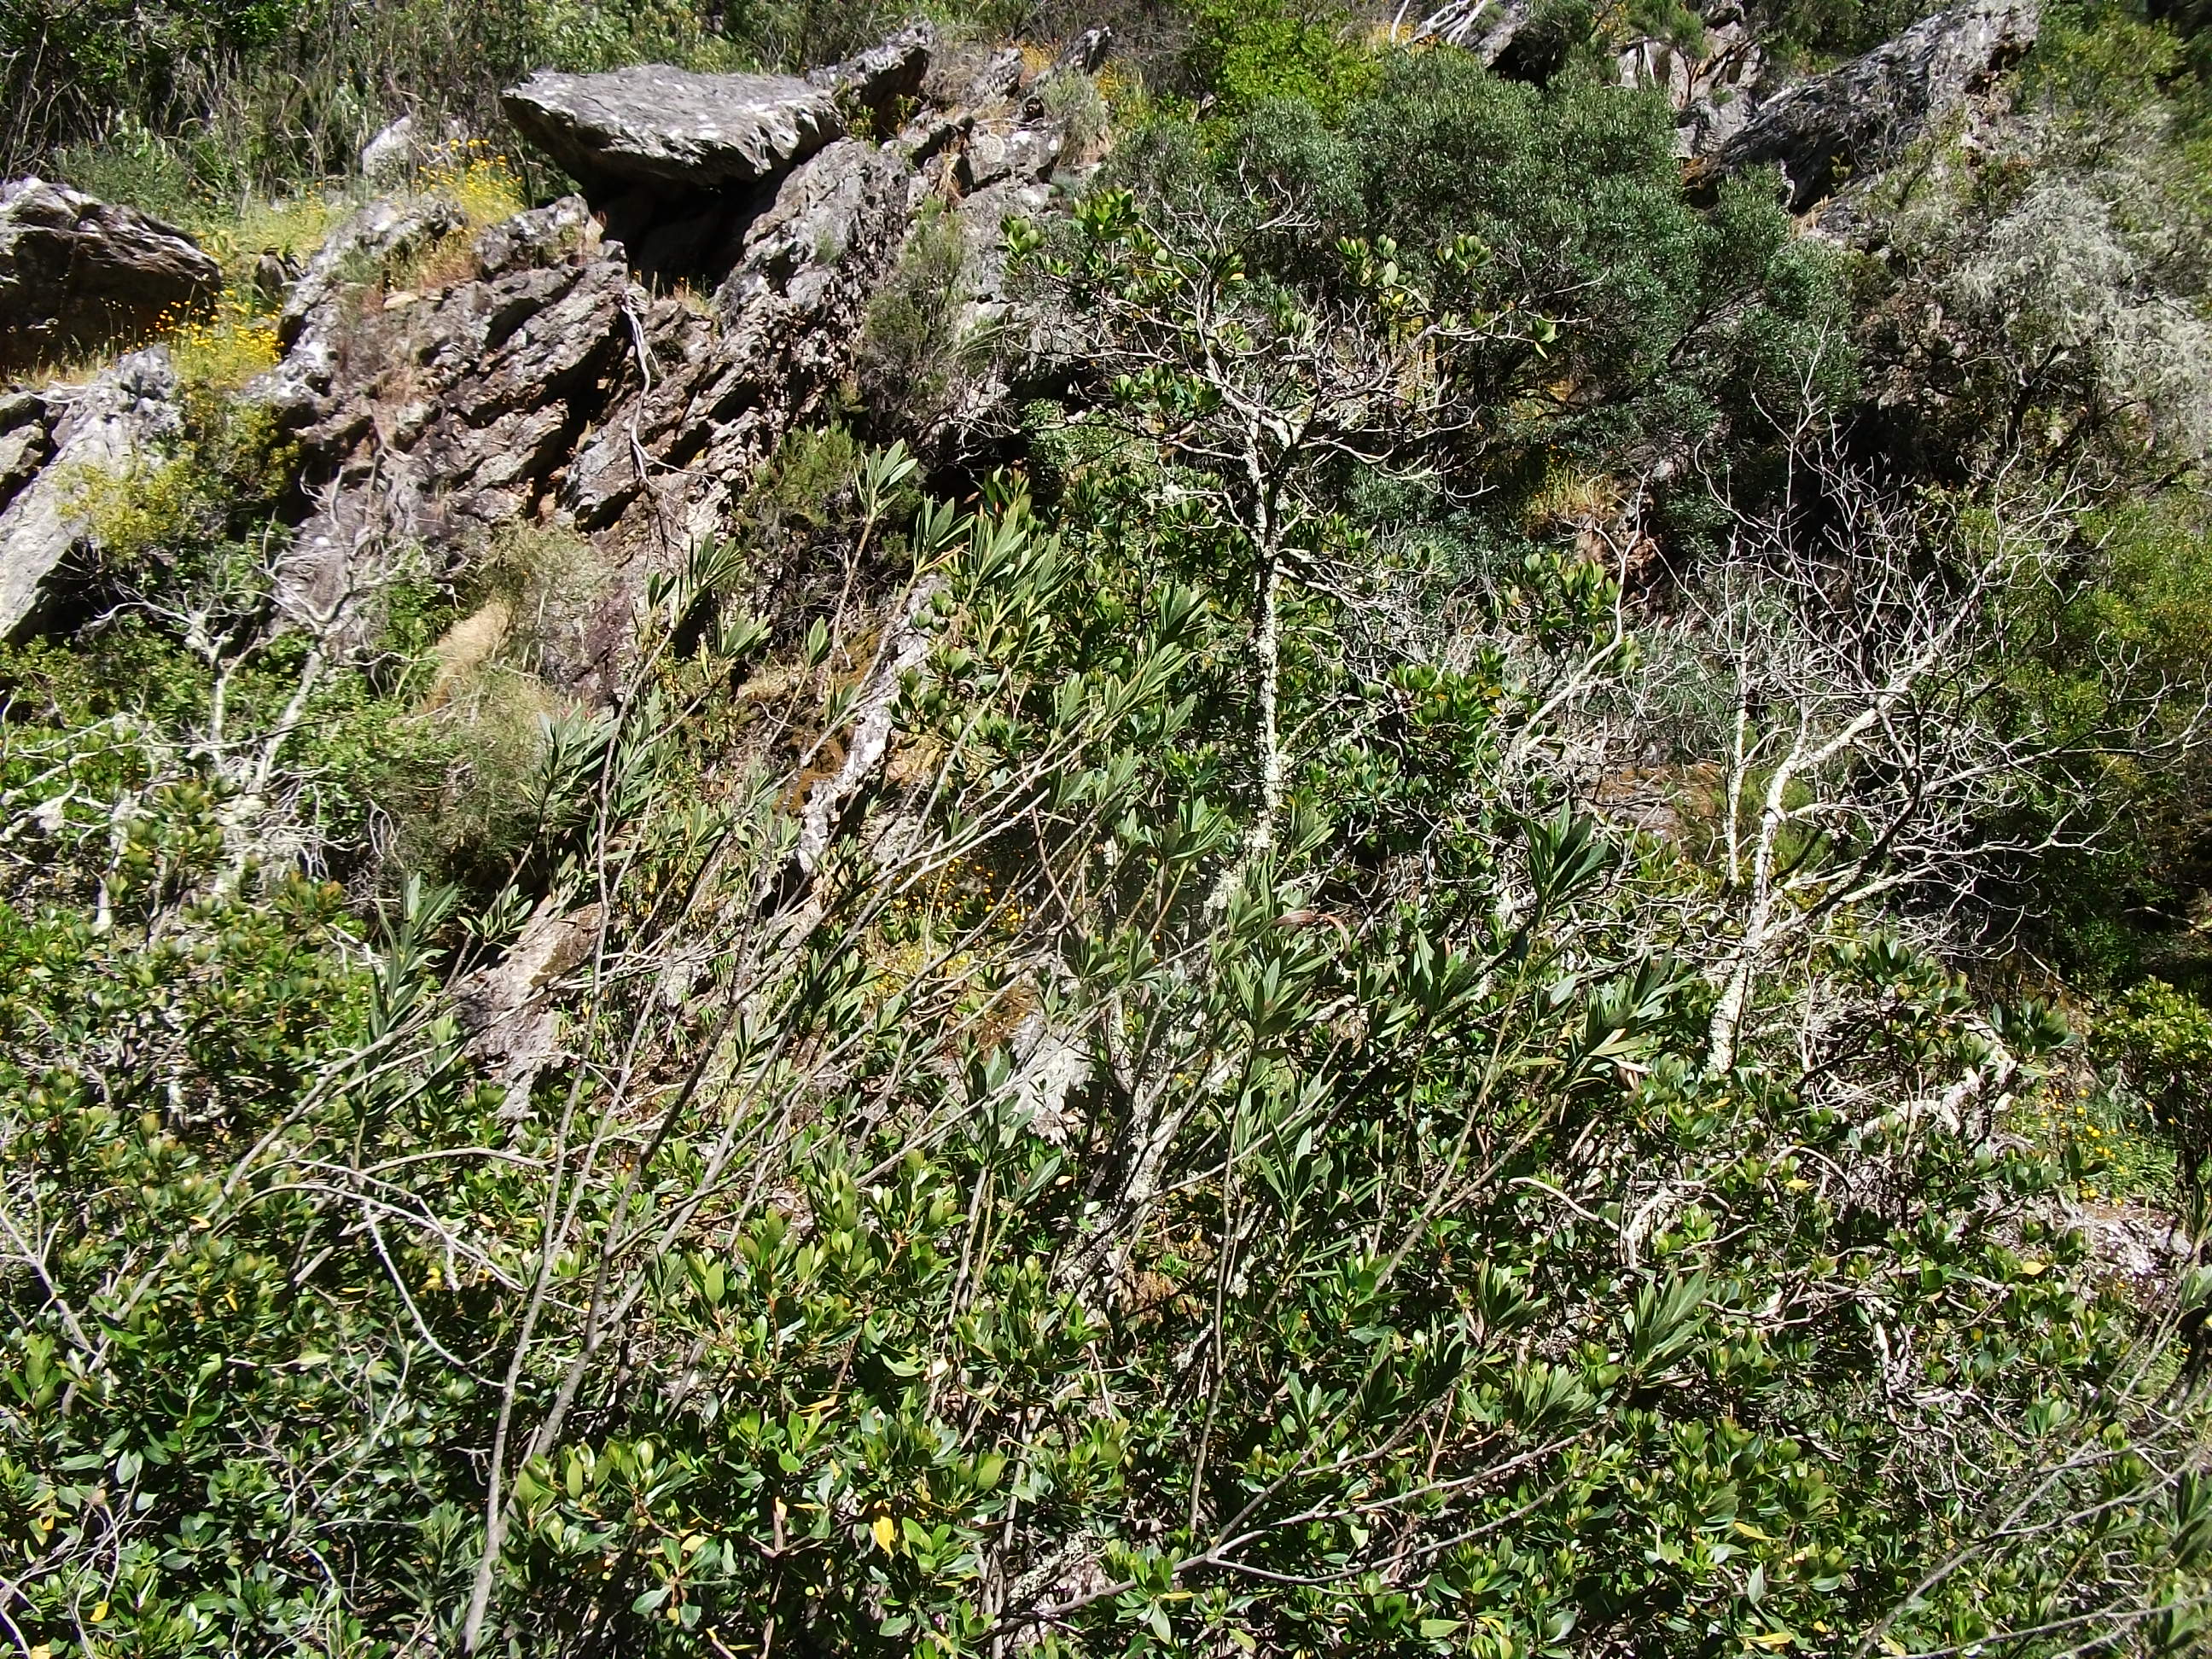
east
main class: Shrubland
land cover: Shrubland with sparse tree cover
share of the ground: 50 - 75 %
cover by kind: shrubs 70 %, herbaceous plants 15 %, consolidated bare surface 10 %, broadleaved forest trees 5 %
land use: Semi-natural and natural areas not in use
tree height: > 5 m
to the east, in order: Shrubland with sparse tree cover; Inland fresh running water; Shrubland without tree cover; Pine dominated coniferous woodland; Shrubland without tree cover
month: May
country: ES
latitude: 37.8213
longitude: -7.1511
